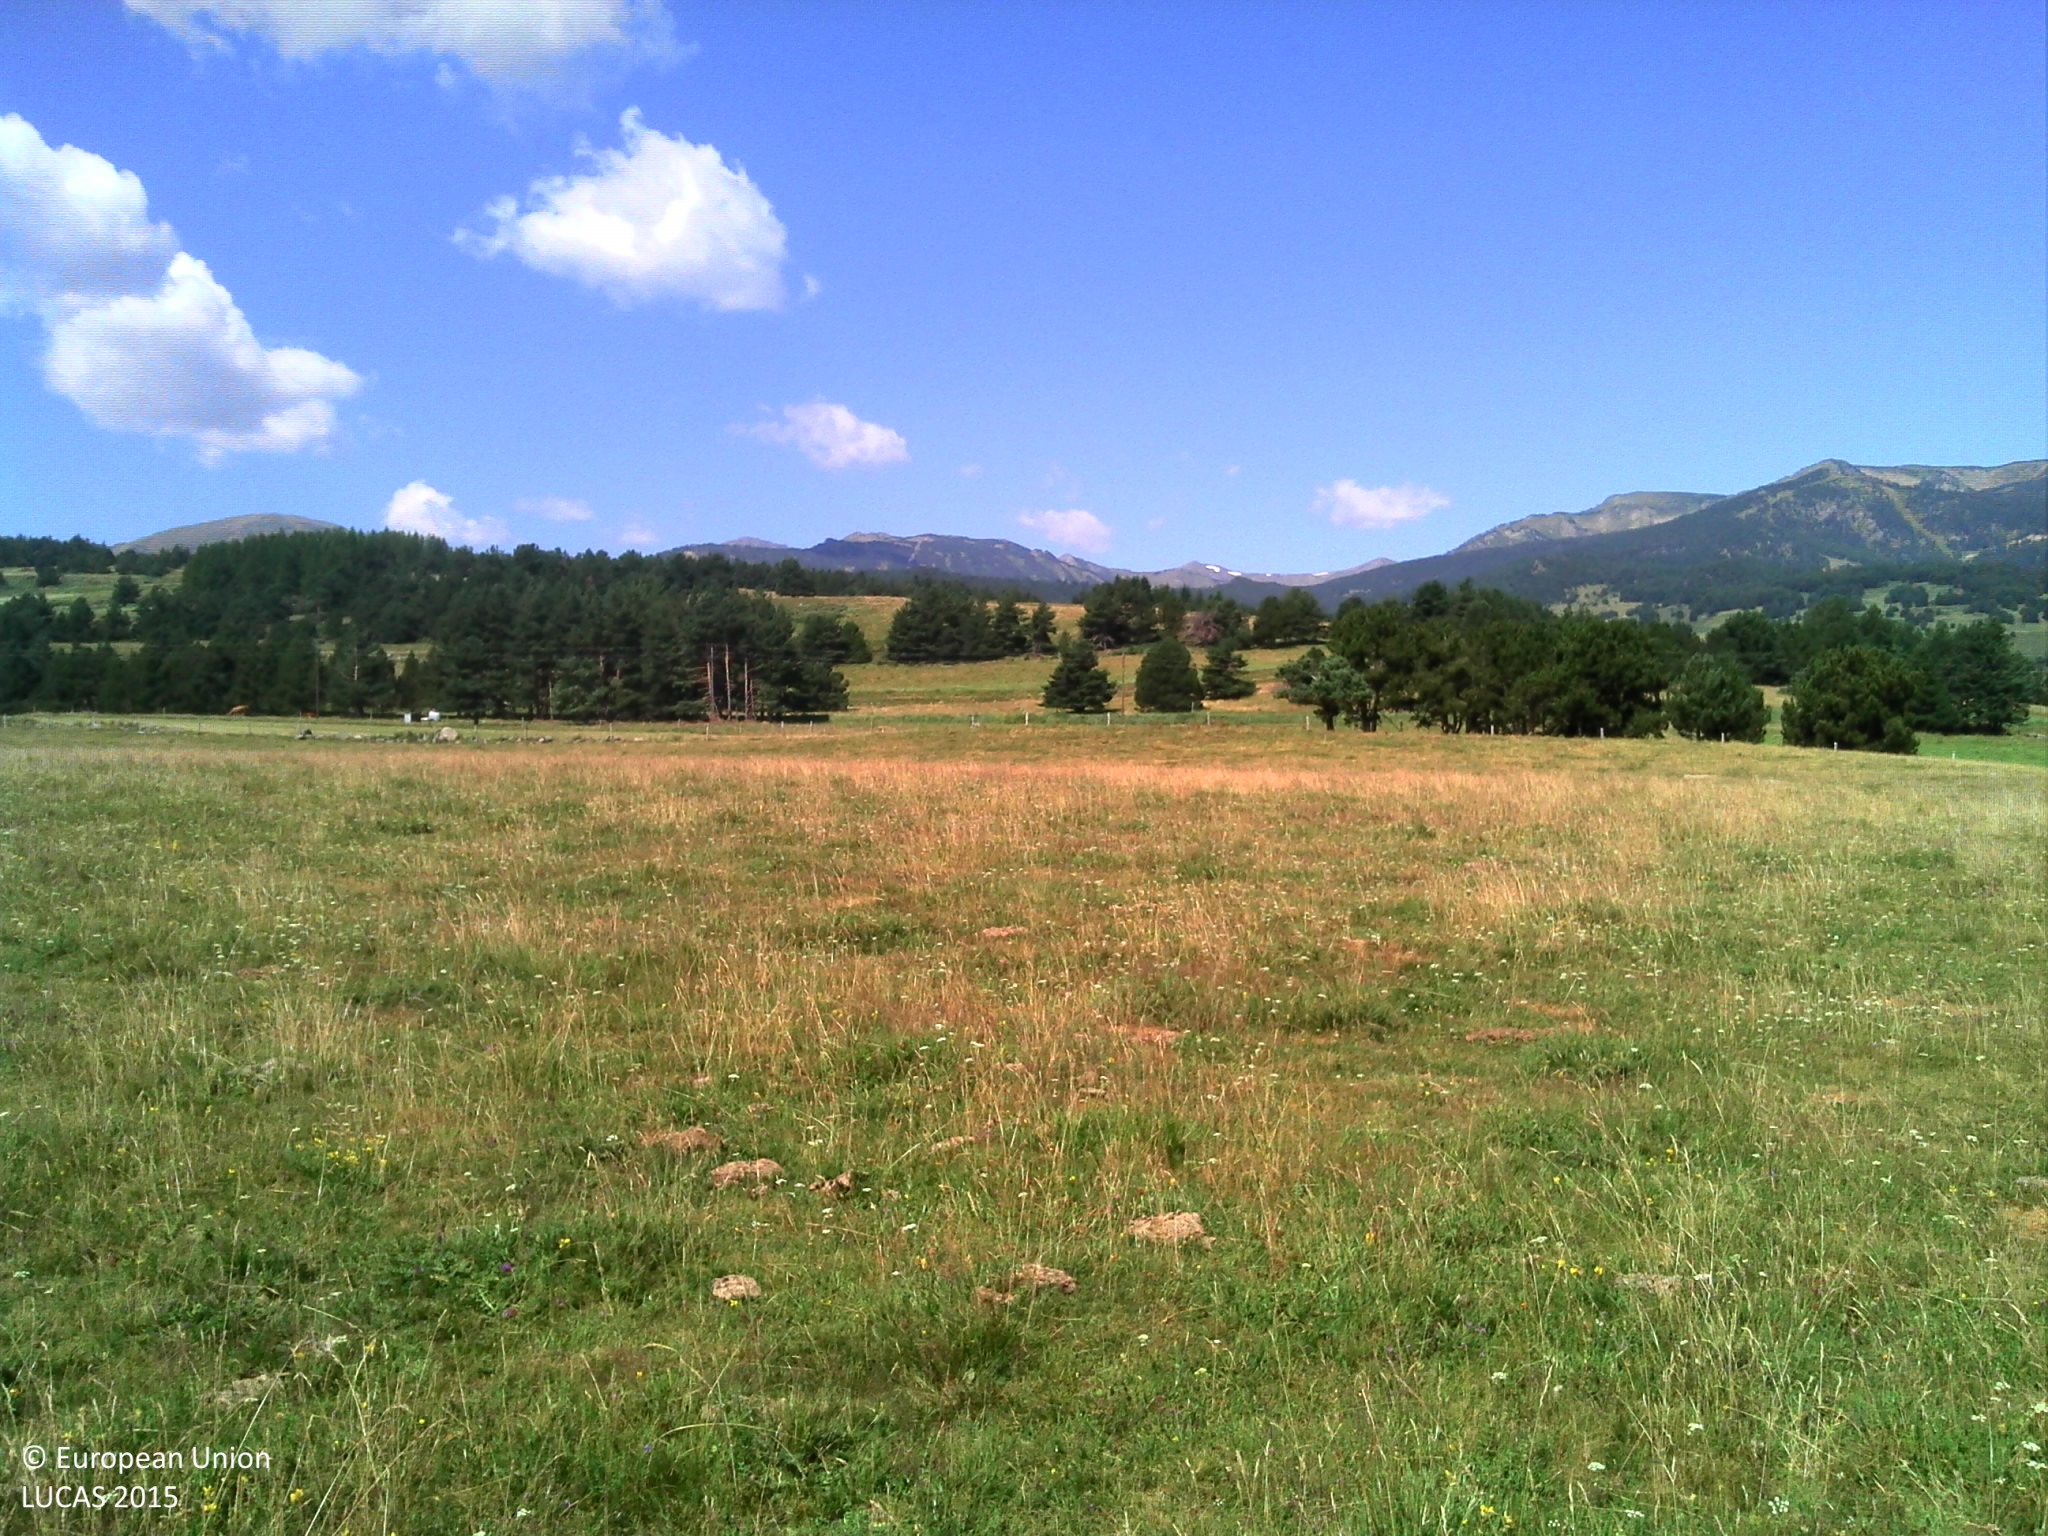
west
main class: Grassland
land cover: Grassland without tree/shrub cover
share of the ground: > 75 %
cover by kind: herbaceous plants 100 %
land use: Agriculture (excluding fallow land and kitchen gardens)
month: July
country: FR
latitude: 42.6369
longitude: 2.1202
